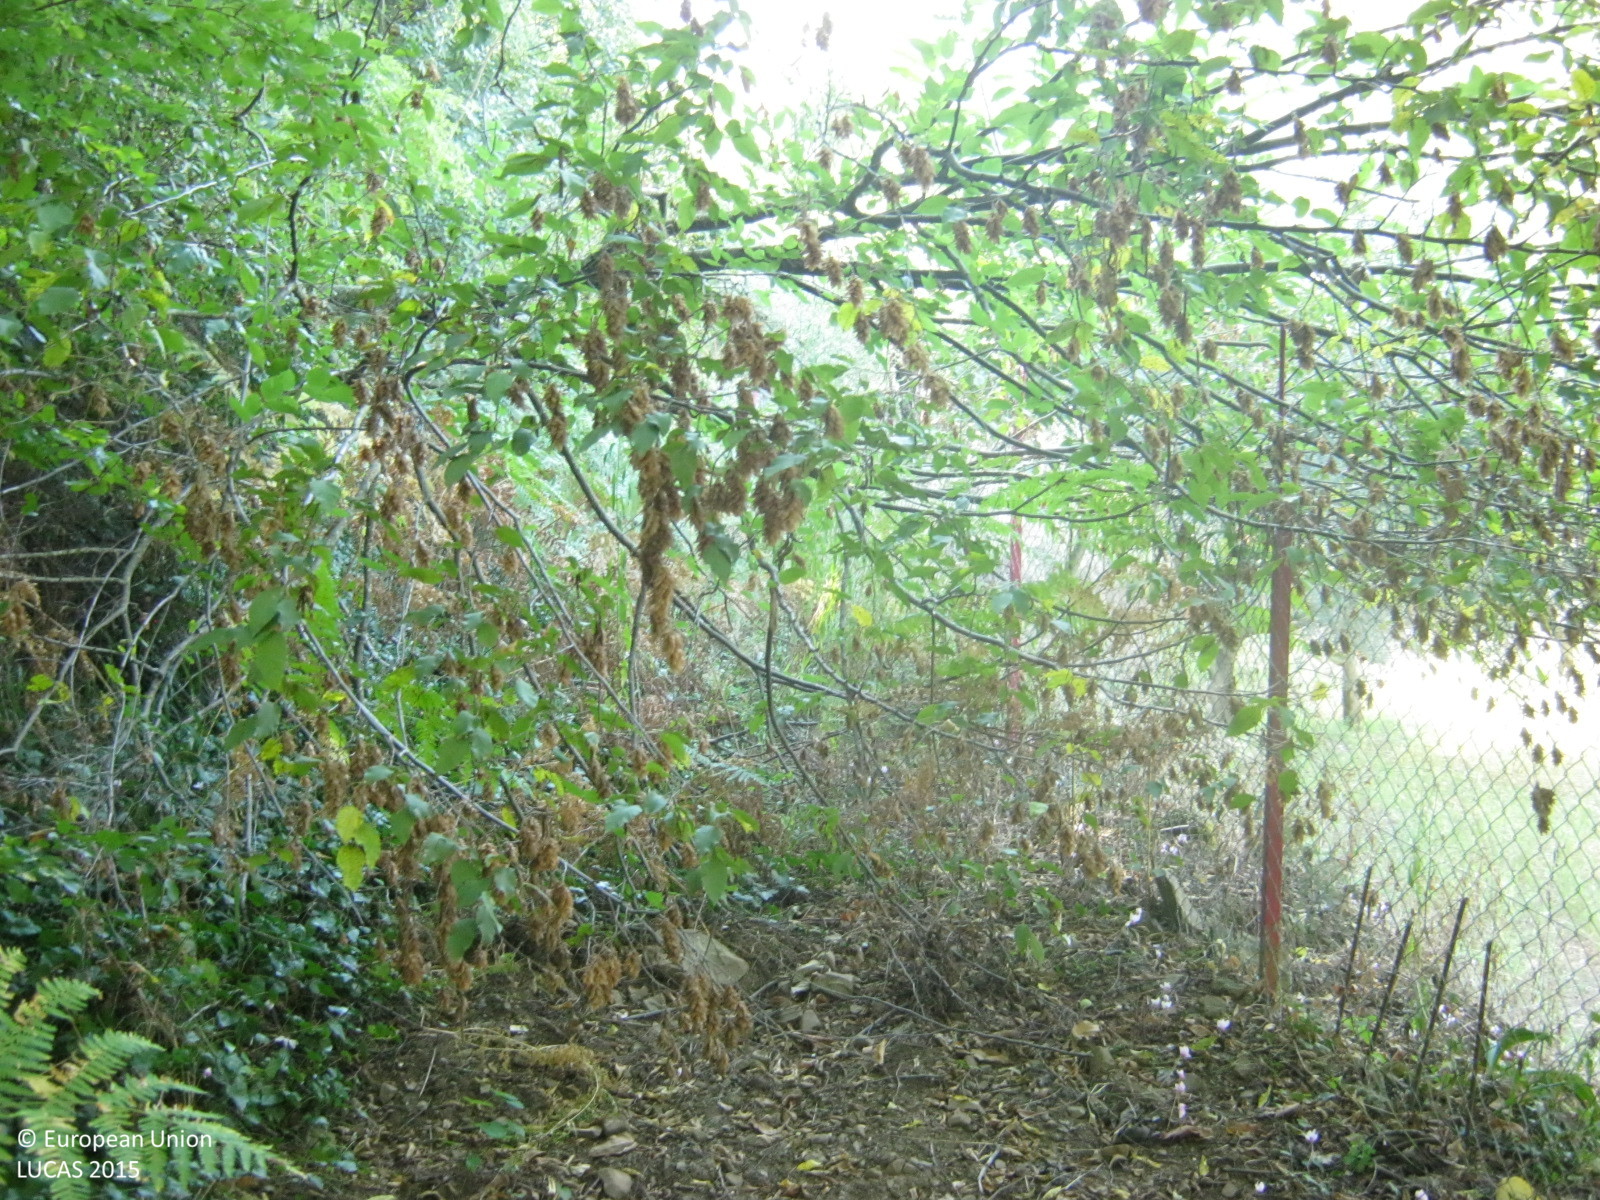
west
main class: Woodland
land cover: Broadleaved woodland
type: thermophilous deciduous forest
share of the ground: > 75 %
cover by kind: broadleaved forest trees 100 %
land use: Semi-natural and natural areas not in use
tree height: > 5 m
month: September
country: GR
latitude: 37.5656
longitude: 22.0404
